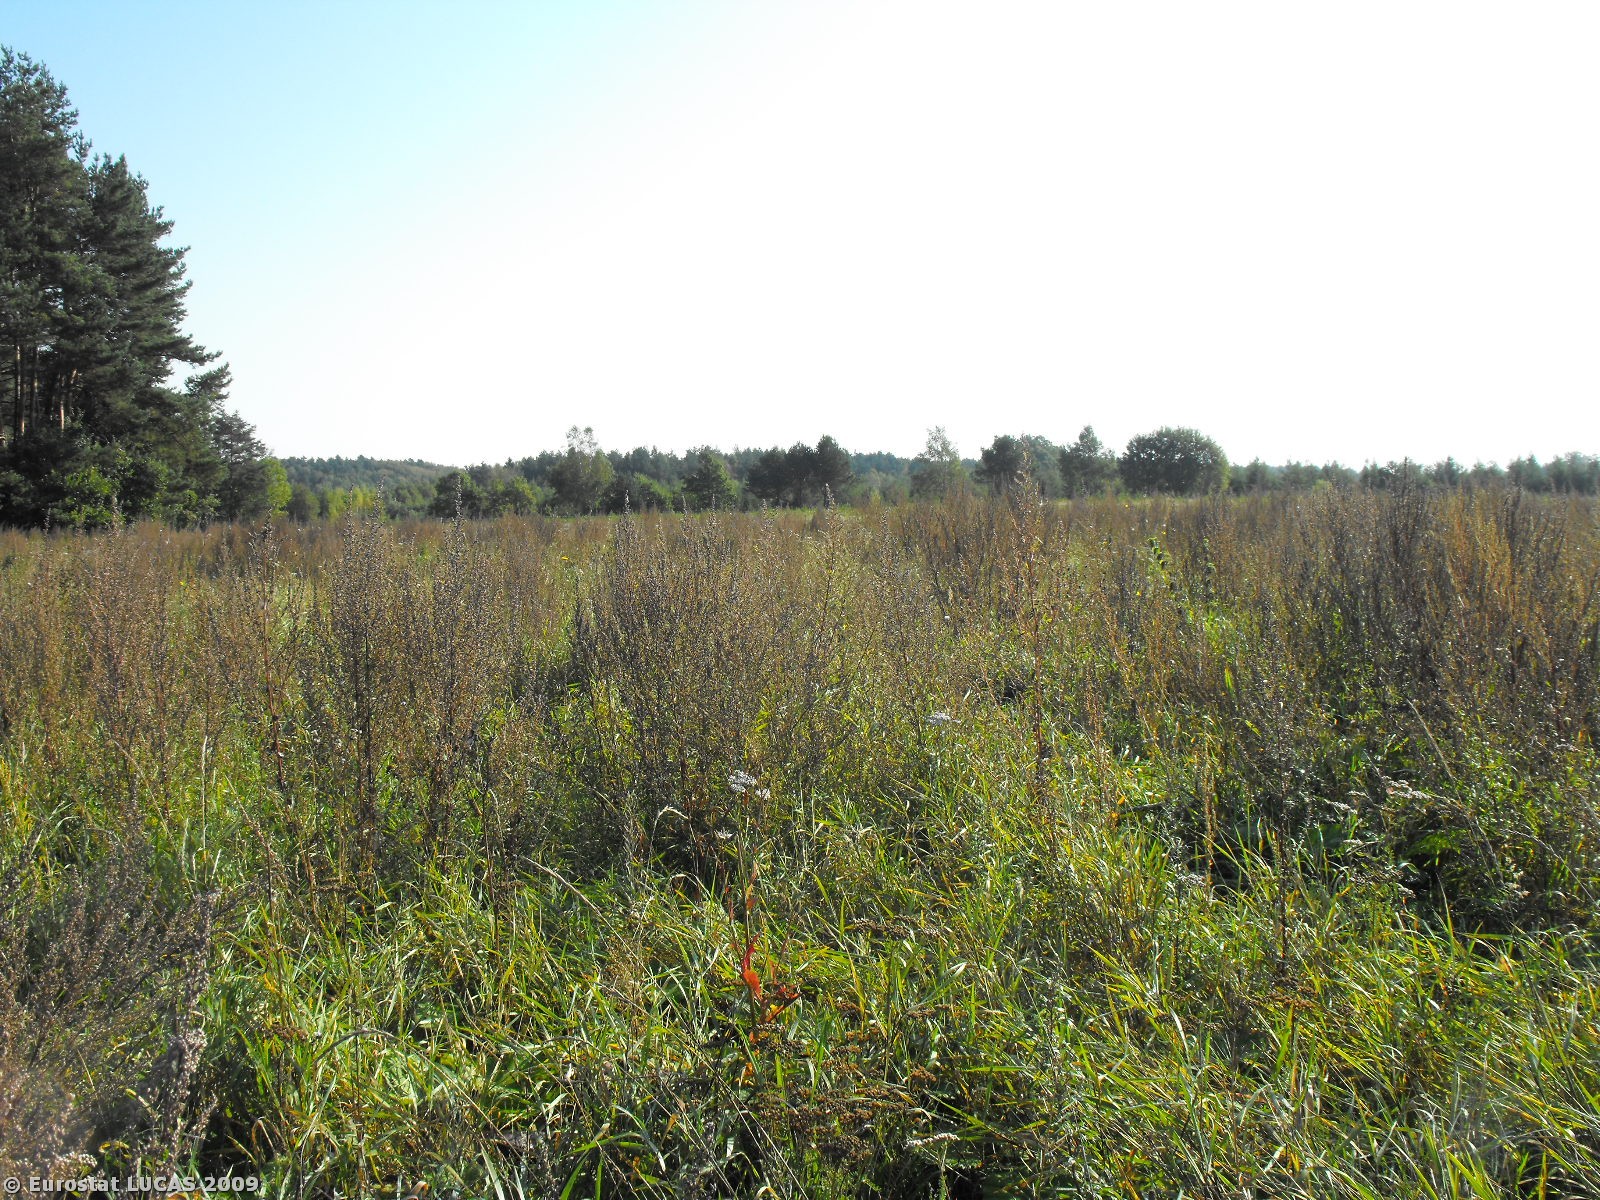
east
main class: Grassland
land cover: Spontaneously vegetated surfaces
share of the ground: > 75 %
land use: Unused
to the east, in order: Spontaneously vegetated surfaces; Grassland with sparse tree/shrub cover; Fences; Lines of trees; Grass margins; Paved roads, cycling and walking lanes; Grass margins; Lines of trees; Fences; Mixed woodland
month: September
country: PL
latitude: 54.4456
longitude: 16.6528
